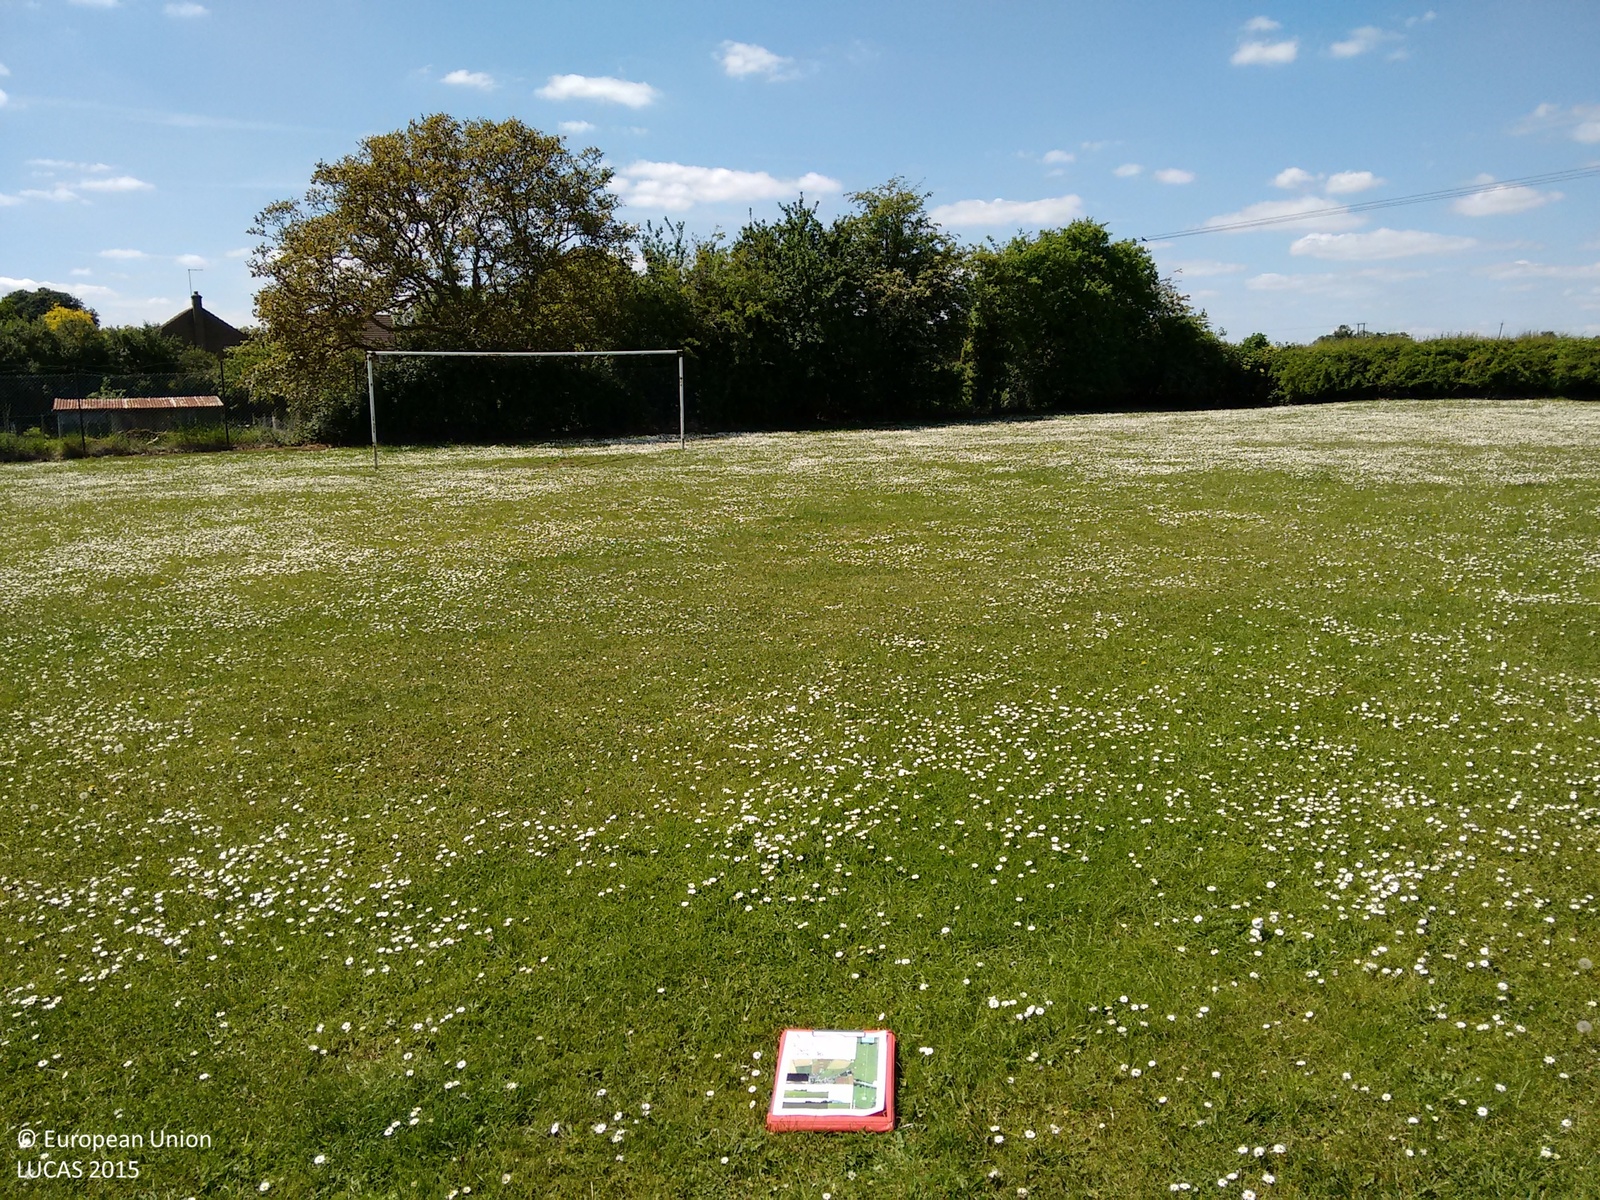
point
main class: Grassland
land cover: Grassland without tree/shrub cover
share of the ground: > 75 %
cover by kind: herbaceous plants 100 %
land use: Sport
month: June
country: GB
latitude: 52.6601
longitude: -0.4308
